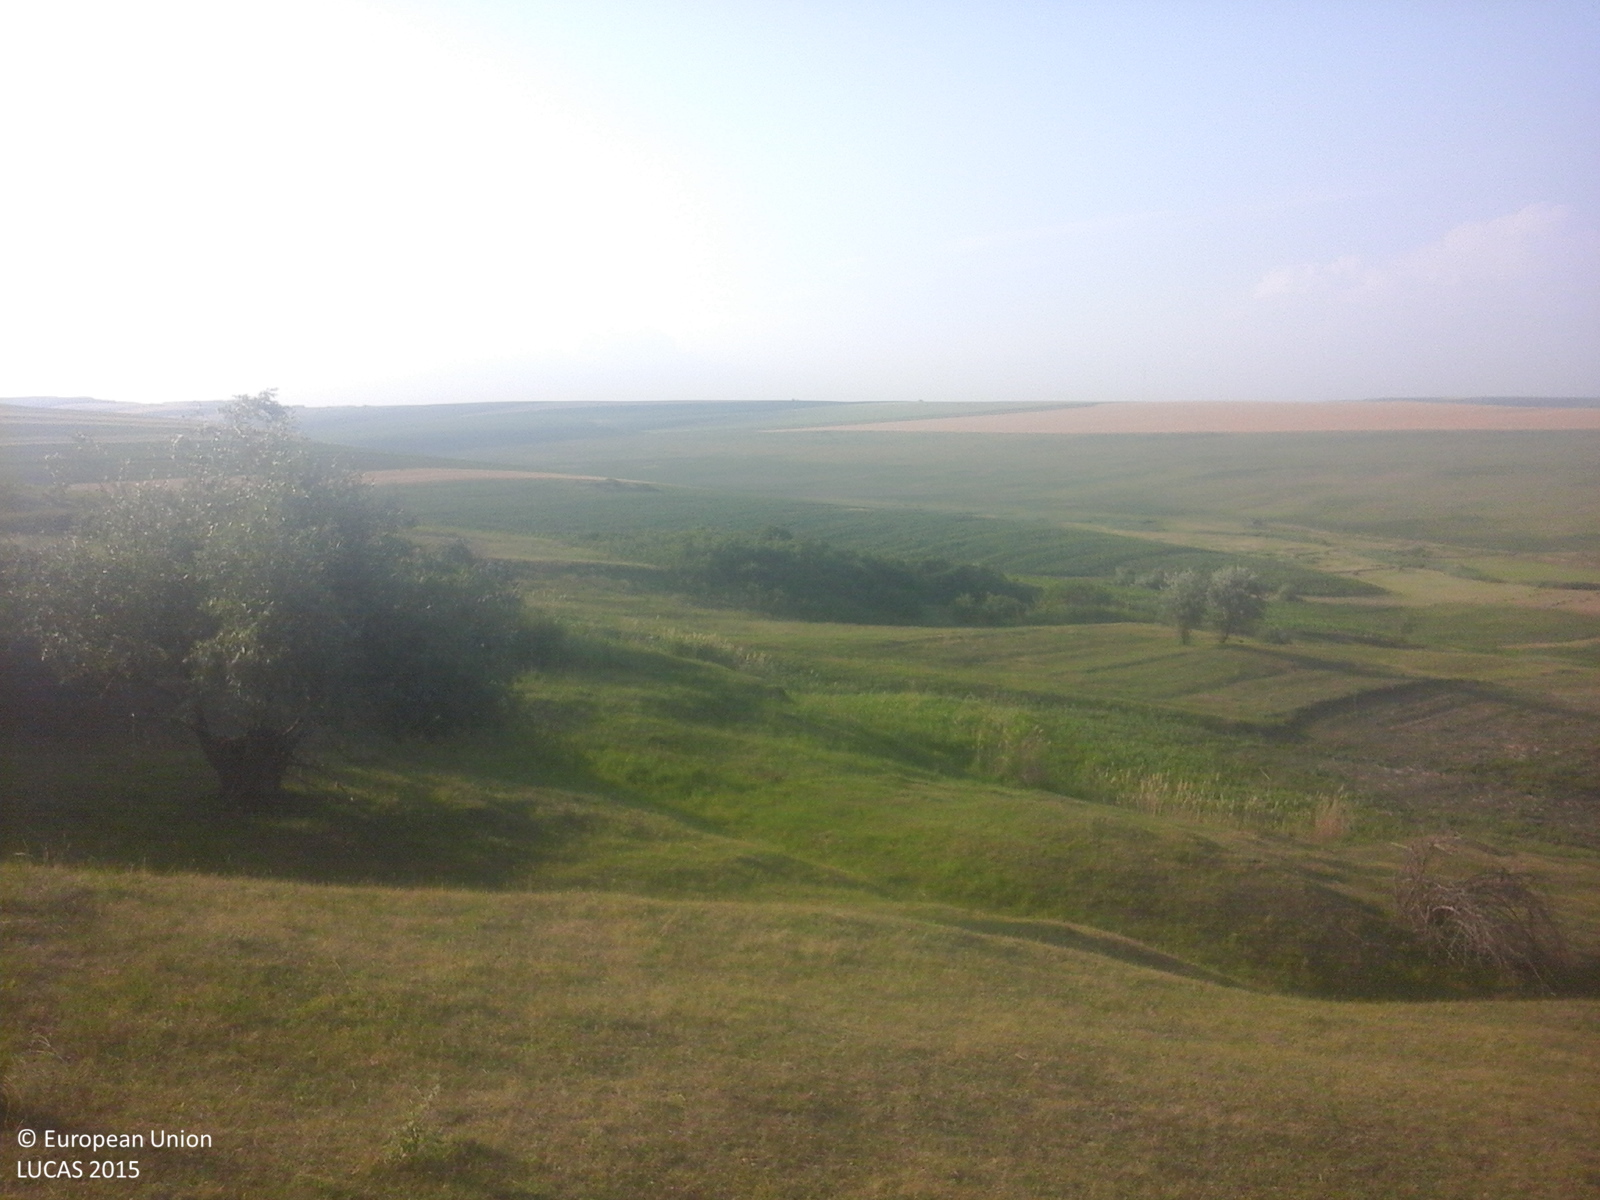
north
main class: Grassland
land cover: Grassland without tree/shrub cover
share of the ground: > 75 %
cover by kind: herbaceous plants 100 %
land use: Agriculture (excluding fallow land and kitchen gardens)
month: June
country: RO
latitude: 46.7354
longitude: 27.7211
